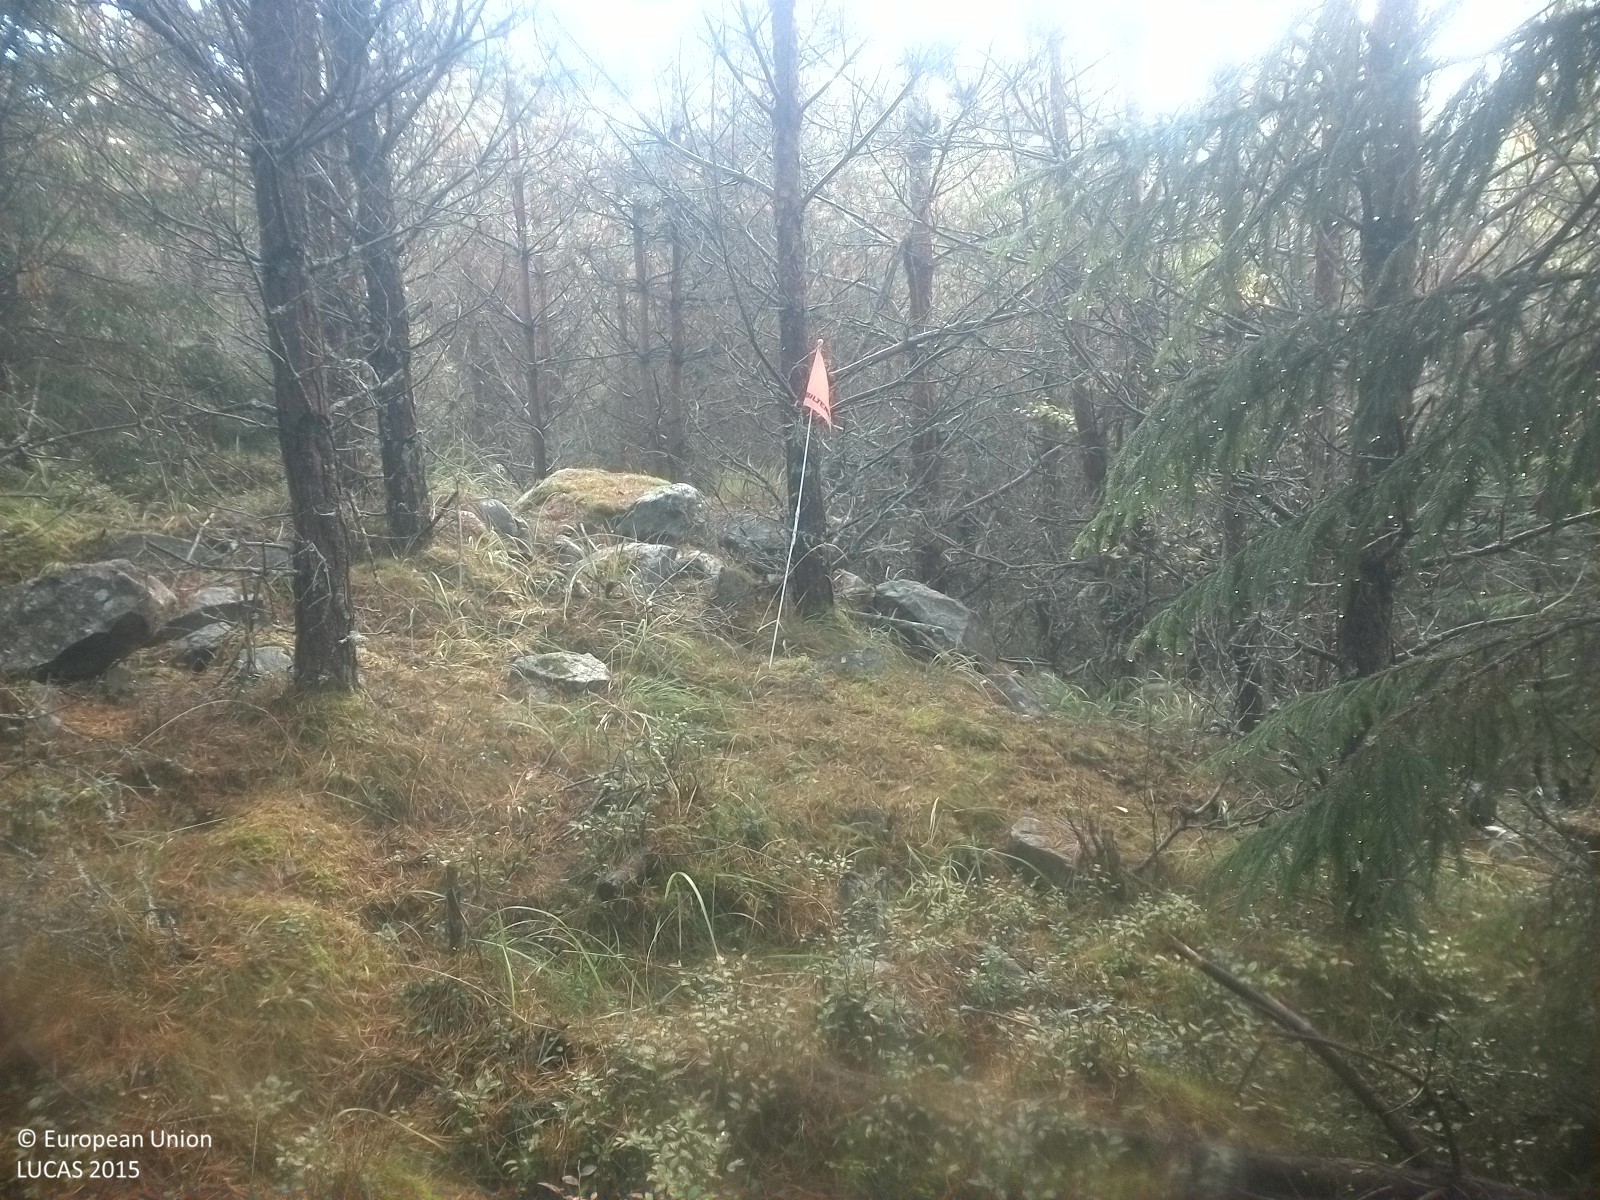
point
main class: Woodland
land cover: Pine dominated coniferous woodland
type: boreal forest
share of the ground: 50 - 75 %
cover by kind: coniferous forest trees 60 %, lichens and mosses 25 %, herbaceous plants 15 %
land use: Forestry
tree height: < 5 m
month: September
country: SE
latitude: 58.7950
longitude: 16.2761
